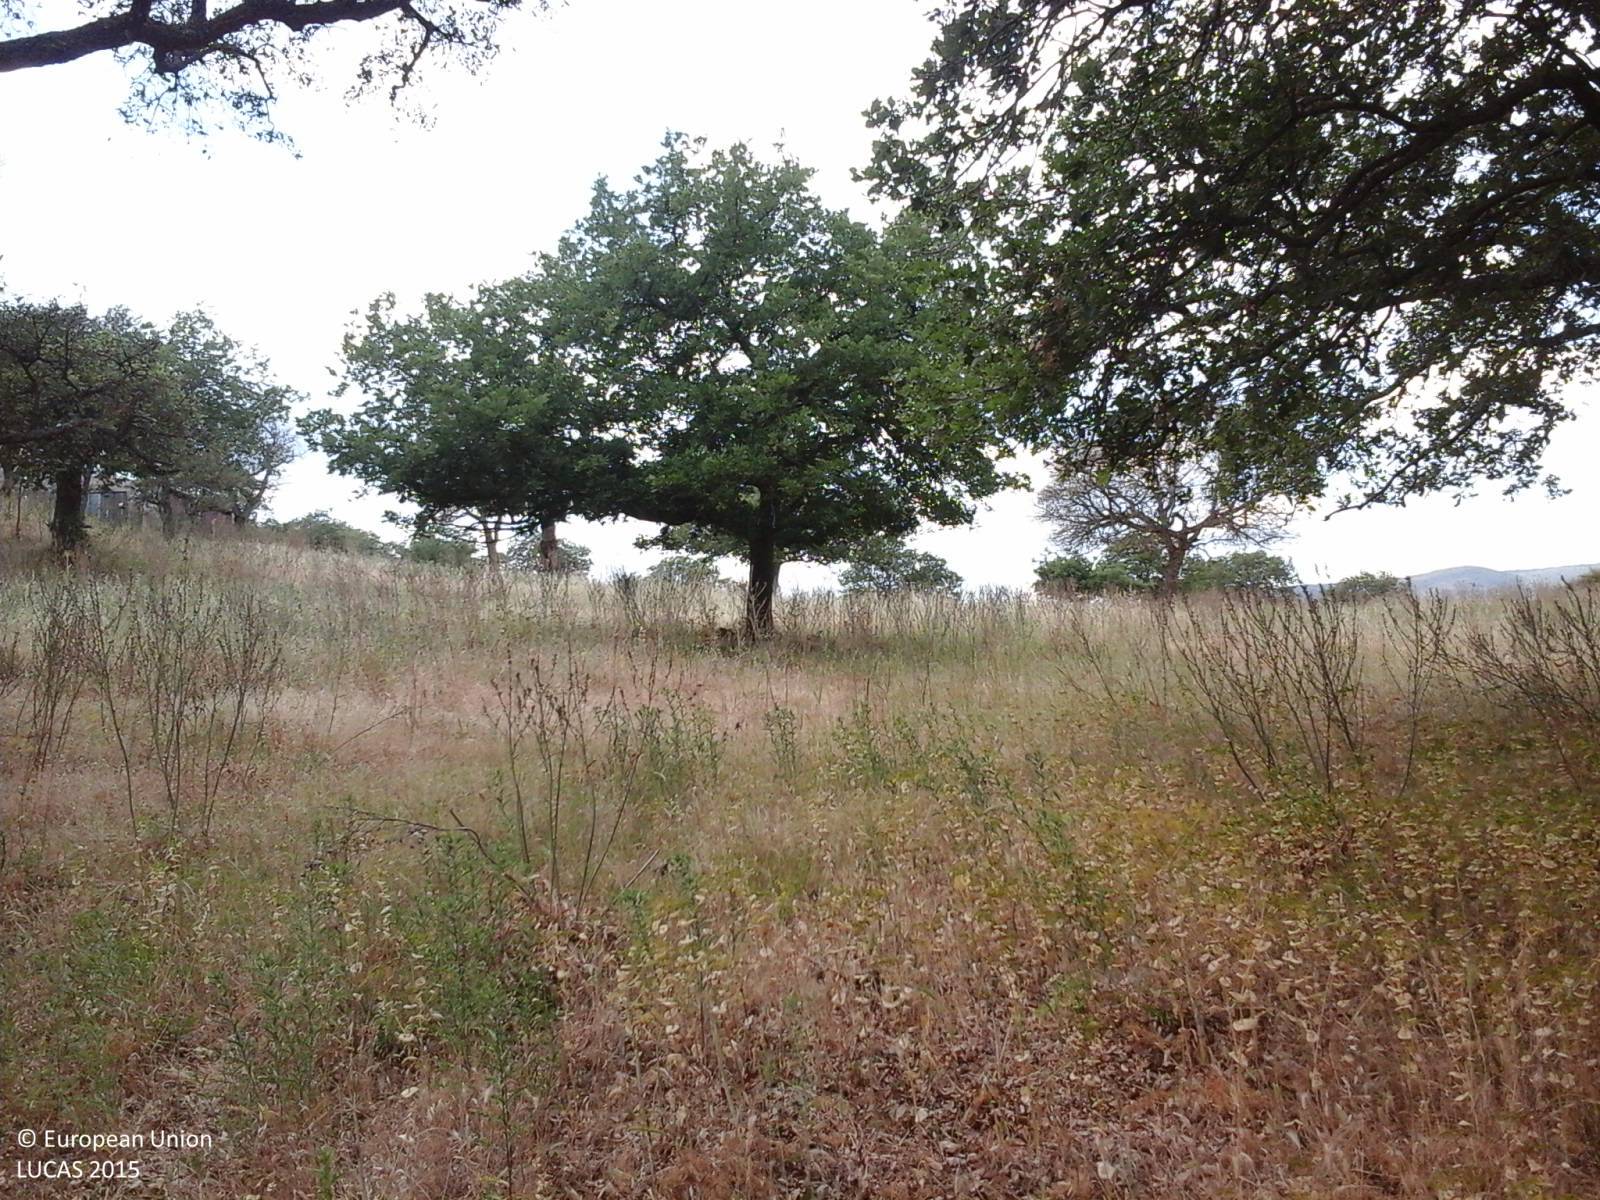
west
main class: Woodland
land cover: Broadleaved woodland
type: broadleaved evergreen forest
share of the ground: > 75 %
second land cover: Grassland without tree/shrub cover
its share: > 75 %
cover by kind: broadleaved forest trees 80 %, herbaceous plants 20 %
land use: Forestry
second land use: Agriculture (excluding fallow land and kitchen gardens)
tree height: > 5 m
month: June
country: IT
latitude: 40.4991
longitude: 9.1664
